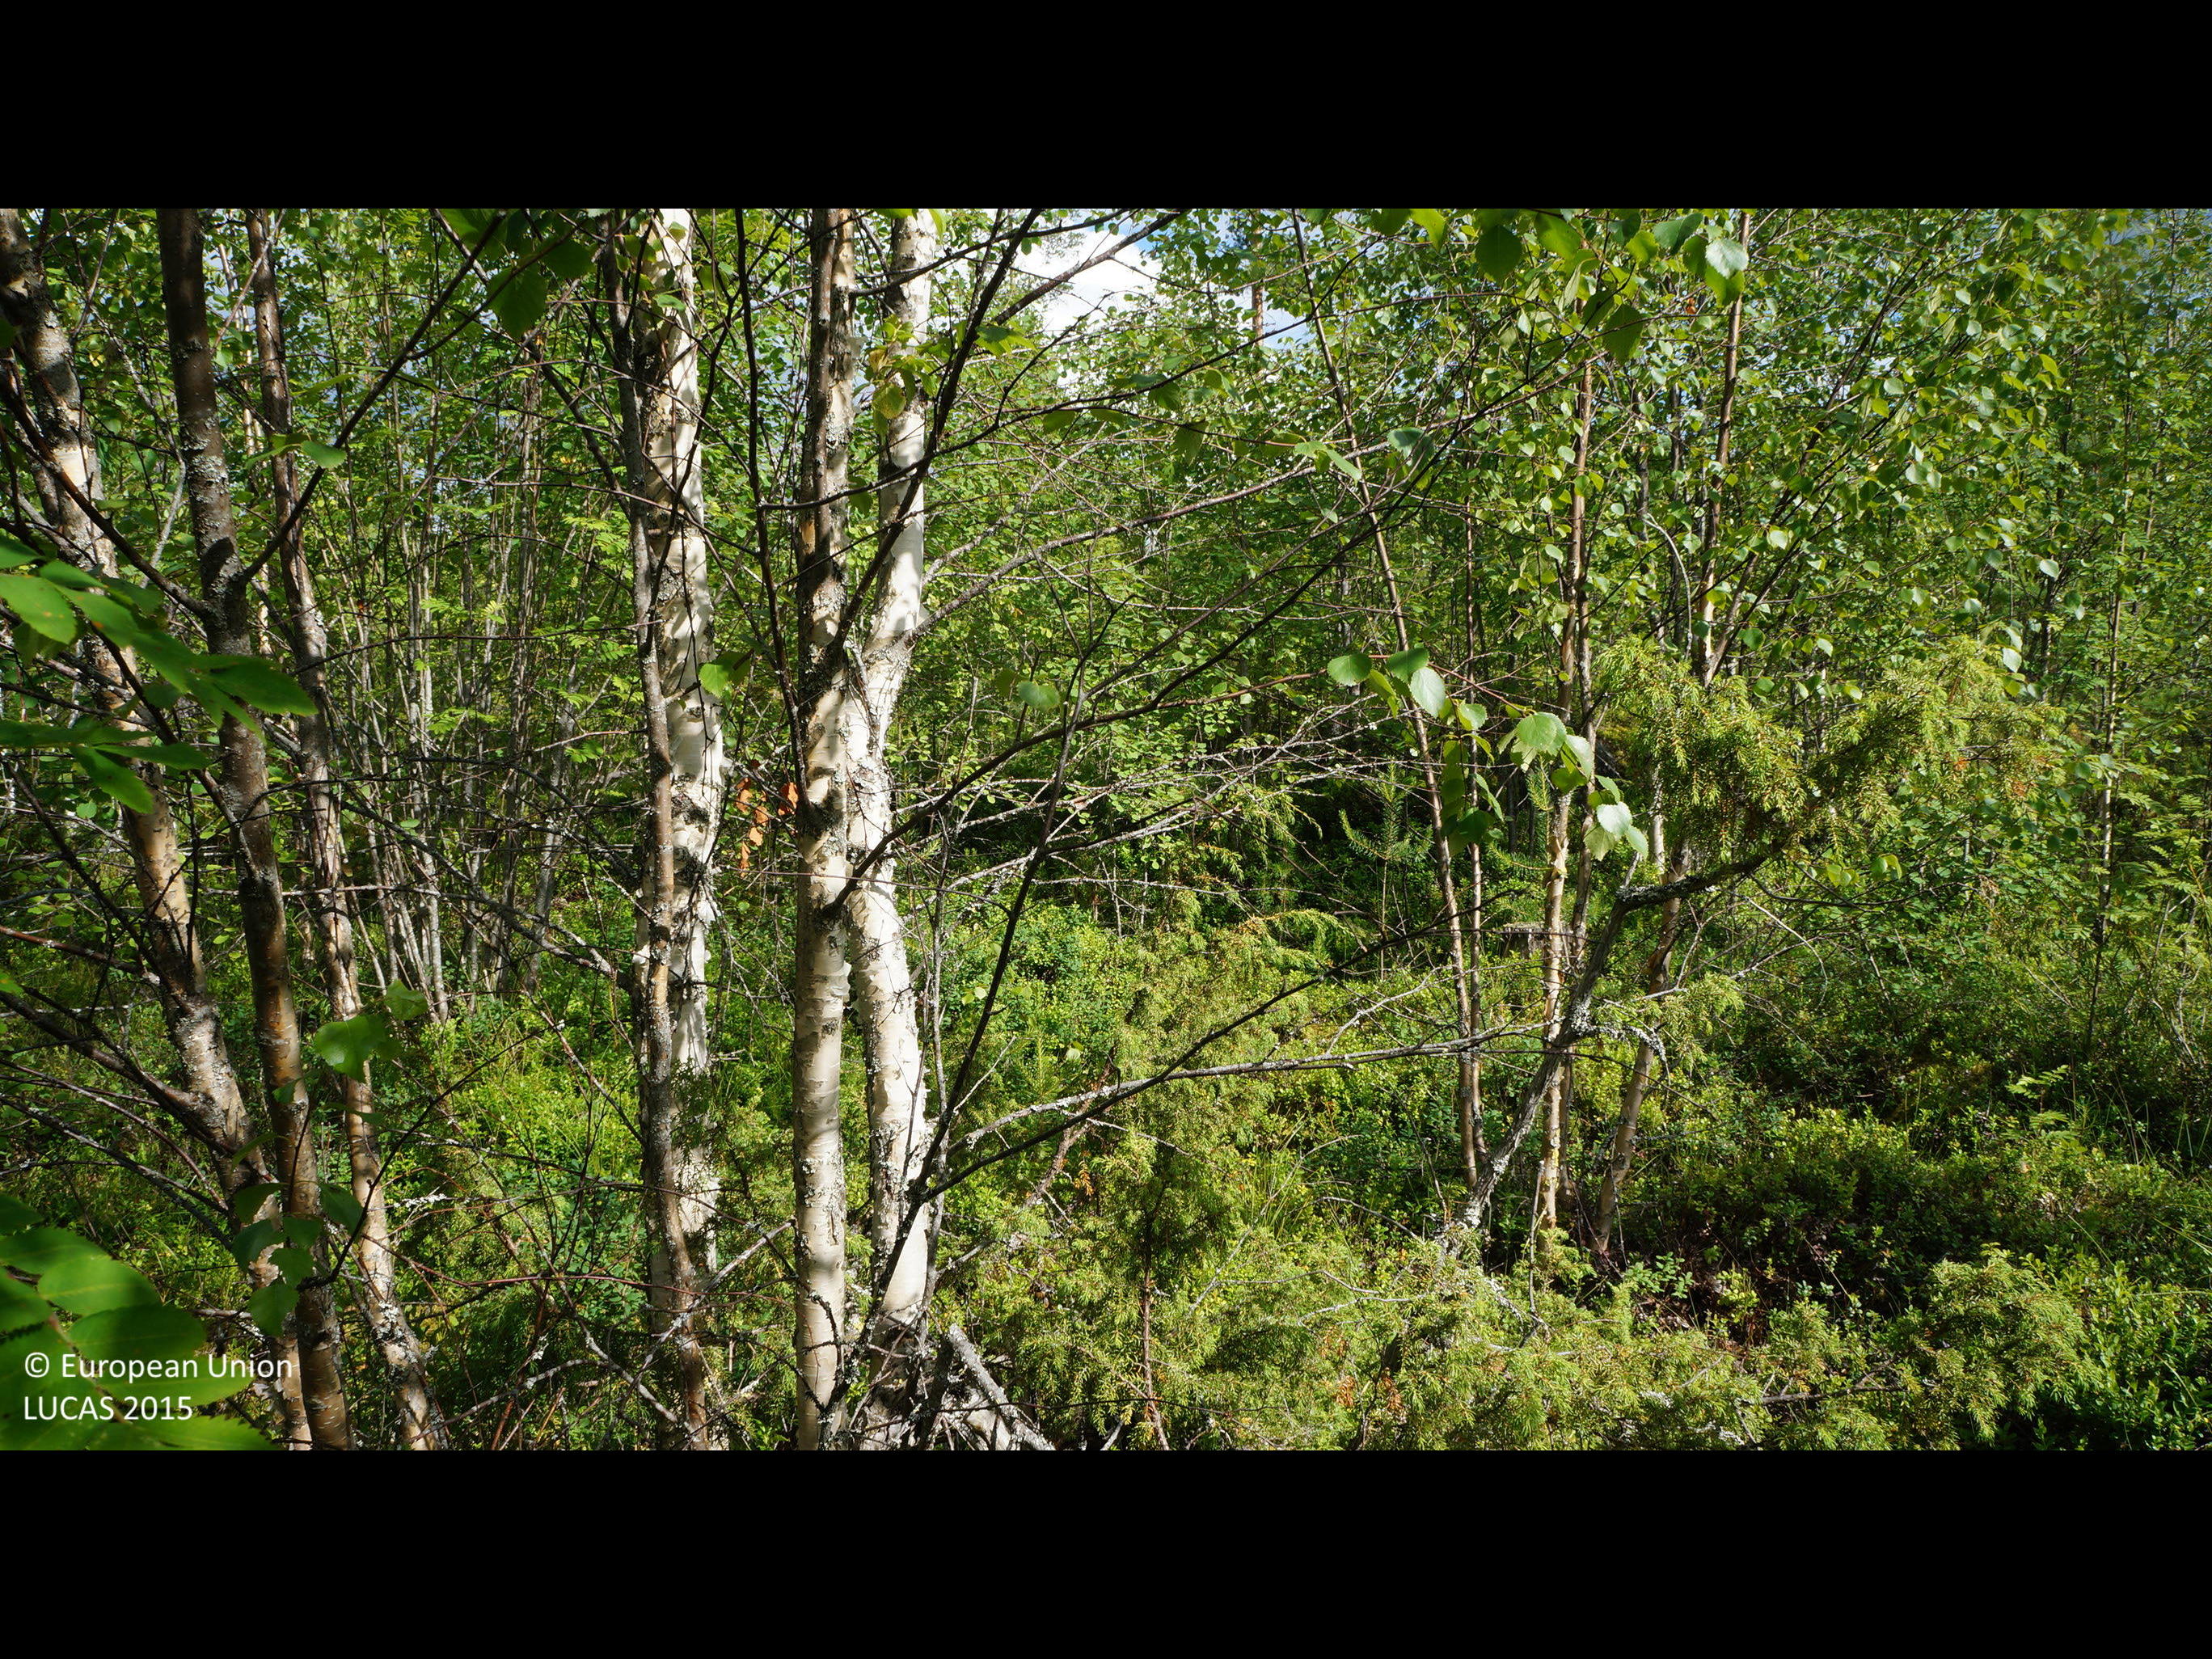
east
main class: Woodland
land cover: Pine dominated mixed woodland
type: boreal forest
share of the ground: 50 - 75 %
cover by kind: shrubs 40 %, coniferous forest trees 25 %, broadleaved forest trees 25 %, herbaceous plants 5 %, lichens and mosses 5 %
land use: Forestry
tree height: > 5 m
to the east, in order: Pine dominated mixed woodland; Broadleaved woodland; Tracks; Broadleaved woodland; Pine dominated mixed woodland
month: July
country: FI
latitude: 64.0018
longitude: 24.3229
